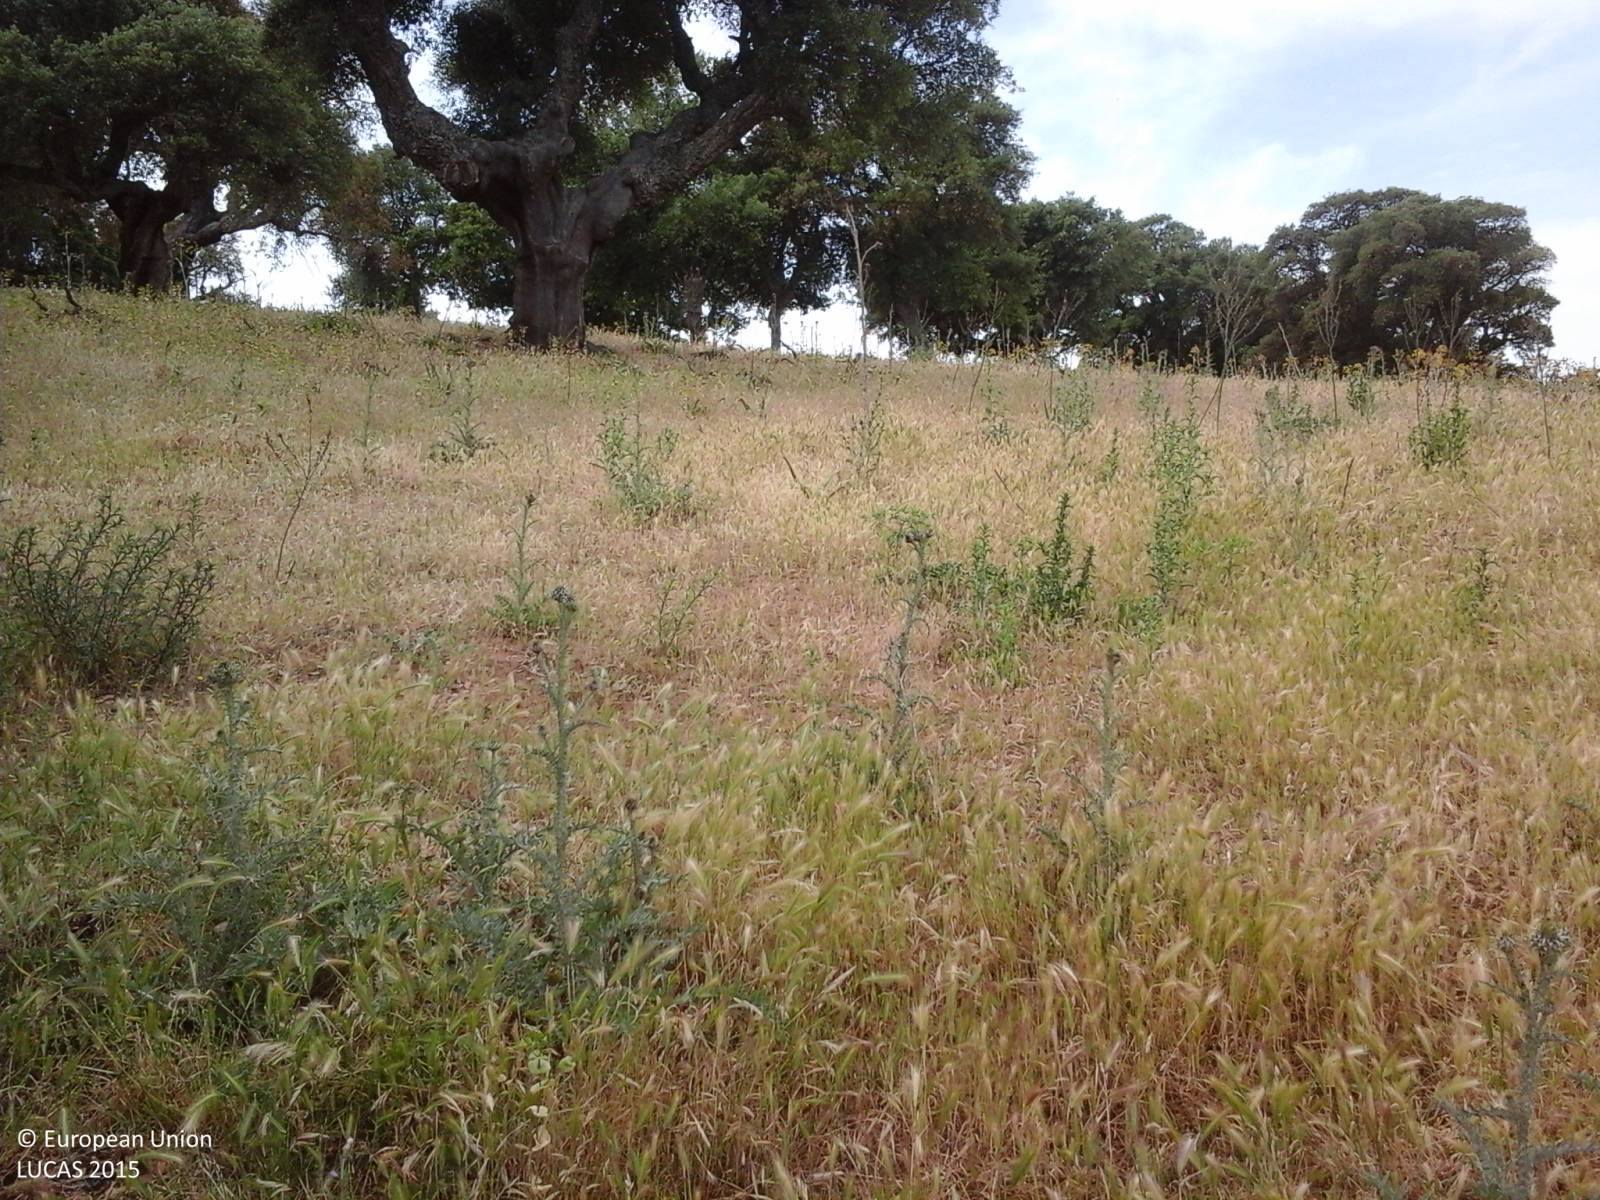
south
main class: Grassland
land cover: Grassland without tree/shrub cover
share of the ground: > 75 %
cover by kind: herbaceous plants 95 %
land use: Agriculture (excluding fallow land and kitchen gardens)
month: May
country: IT
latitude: 40.2827
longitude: 9.2629
